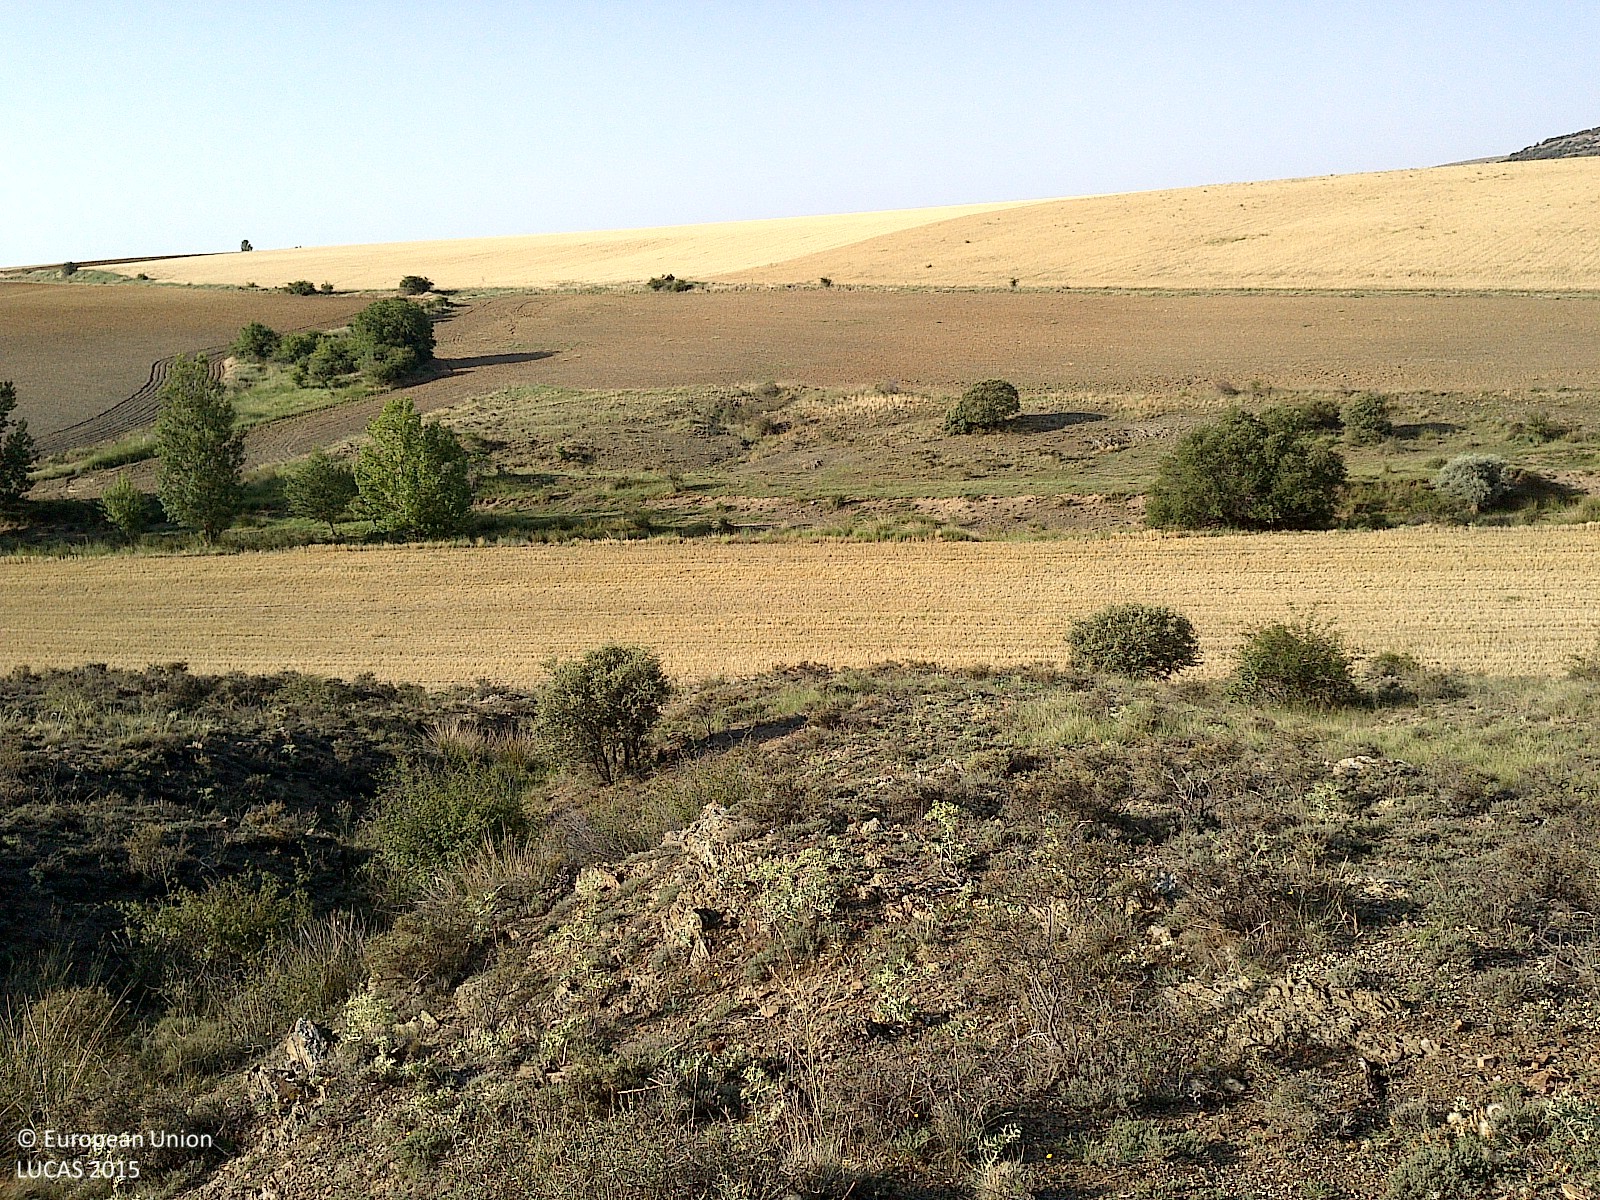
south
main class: Shrubland
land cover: Shrubland without tree cover
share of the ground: 25 - 50 %
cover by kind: consolidated bare surface 50 %, shrubs 25 %, herbaceous plants 10 %, unconsolidated bare surface 10 %, lichens and mosses 5 %
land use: Agriculture (excluding fallow land and kitchen gardens)
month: July
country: ES
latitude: 41.5003
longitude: -1.9977
